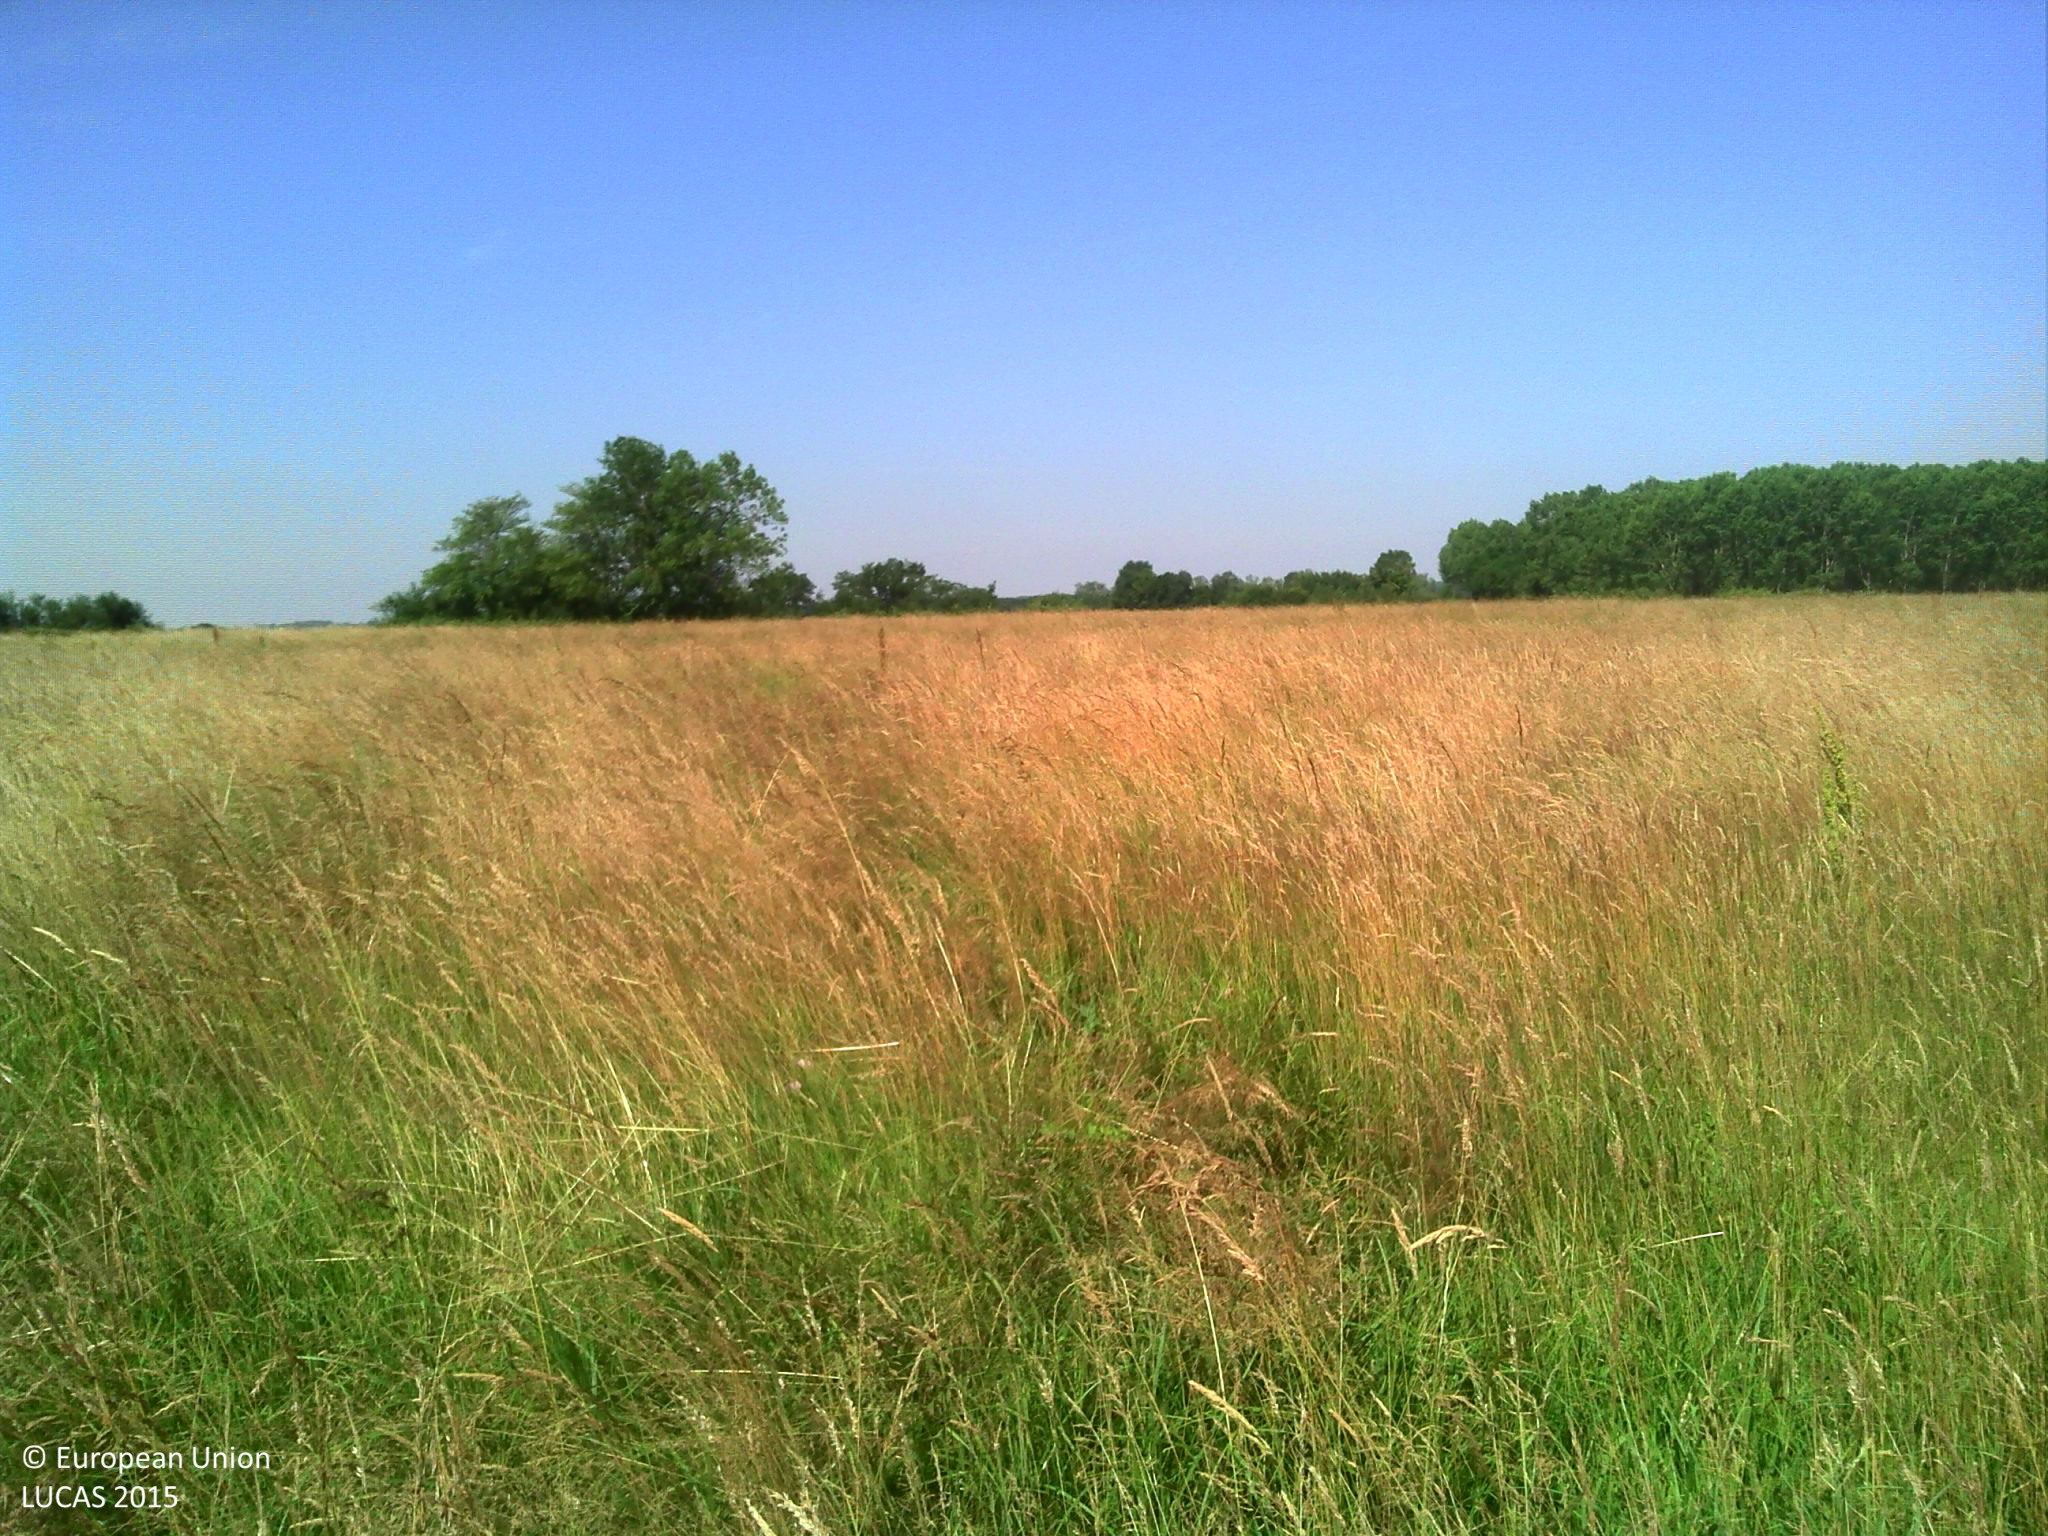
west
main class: Grassland
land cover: Grassland without tree/shrub cover
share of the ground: > 75 %
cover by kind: herbaceous plants 100 %
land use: Agriculture (excluding fallow land and kitchen gardens)
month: June
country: FR
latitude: 46.7543
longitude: 5.3284
